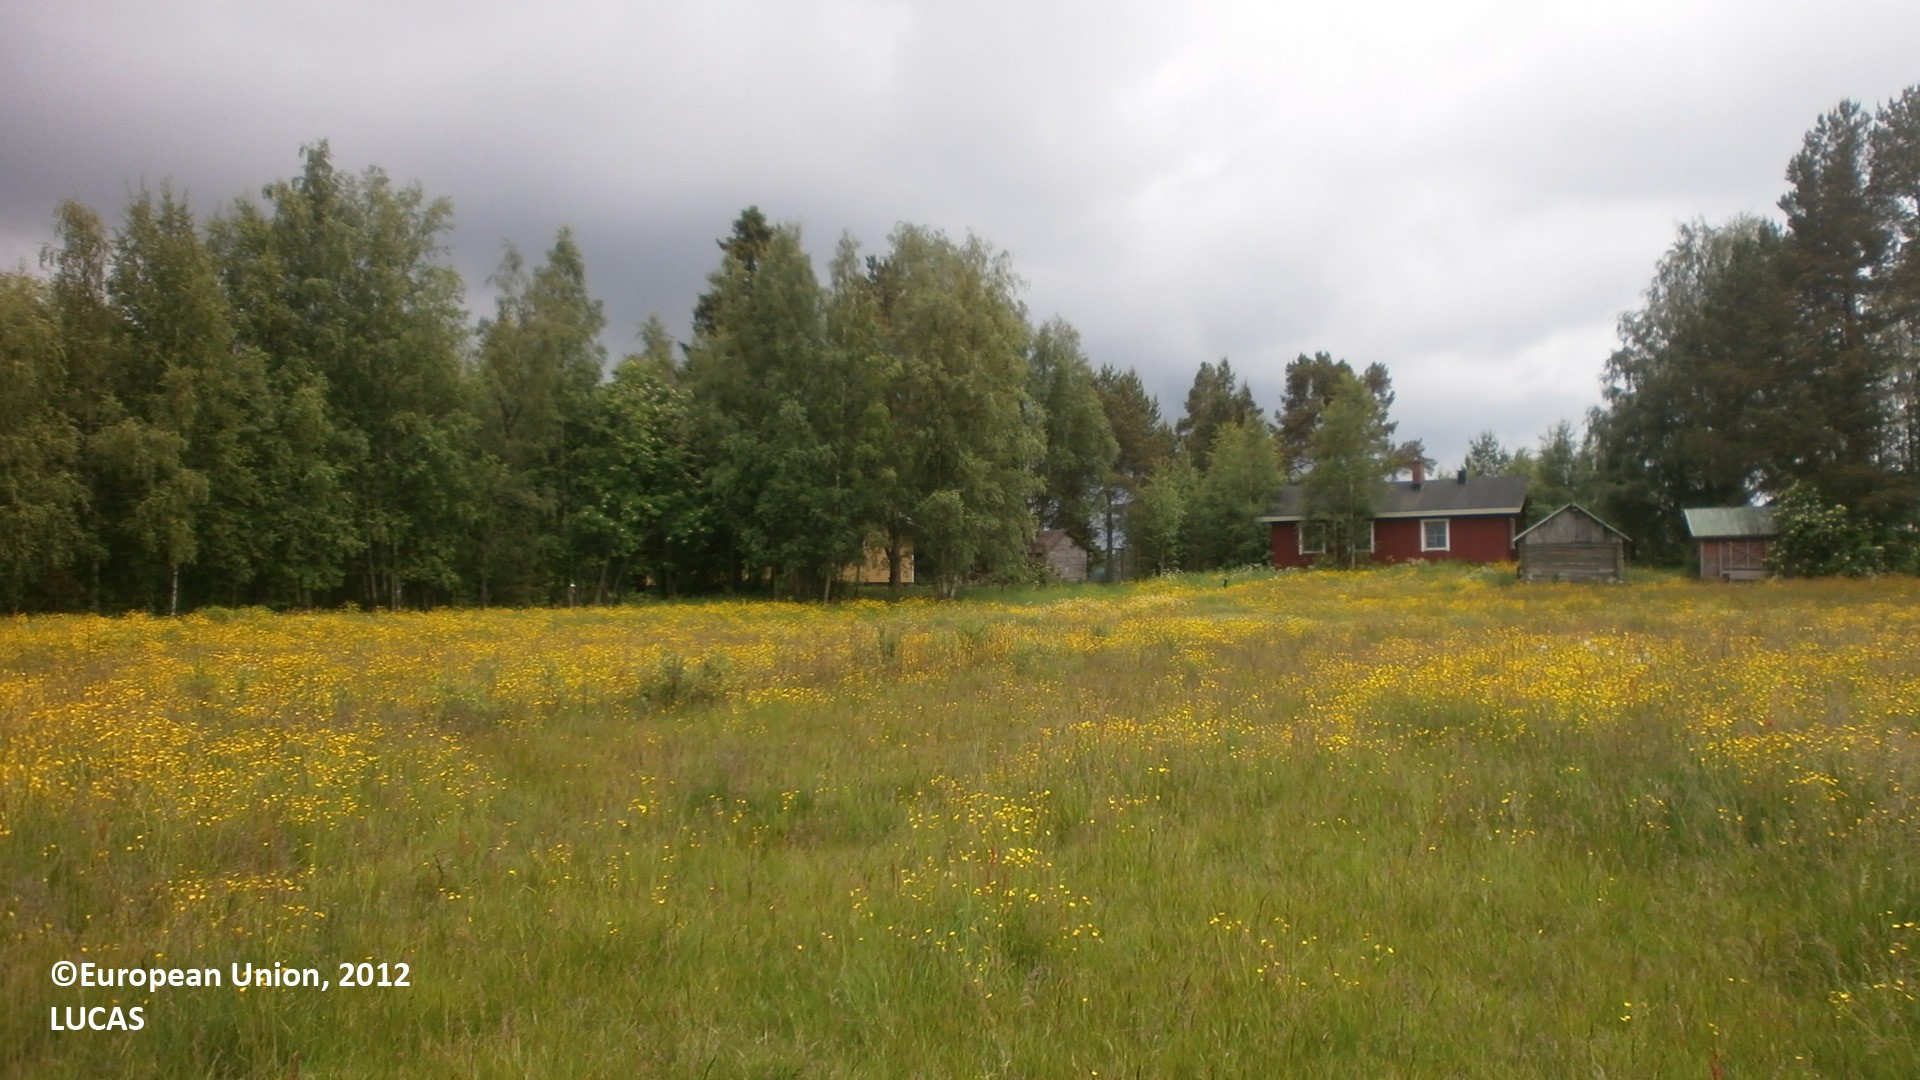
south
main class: Grassland
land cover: Grassland without tree/shrub cover
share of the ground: > 75 %
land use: Agriculture (excluding fallow land and kitchen gardens)
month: June
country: FI
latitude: 64.8133
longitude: 25.3082
